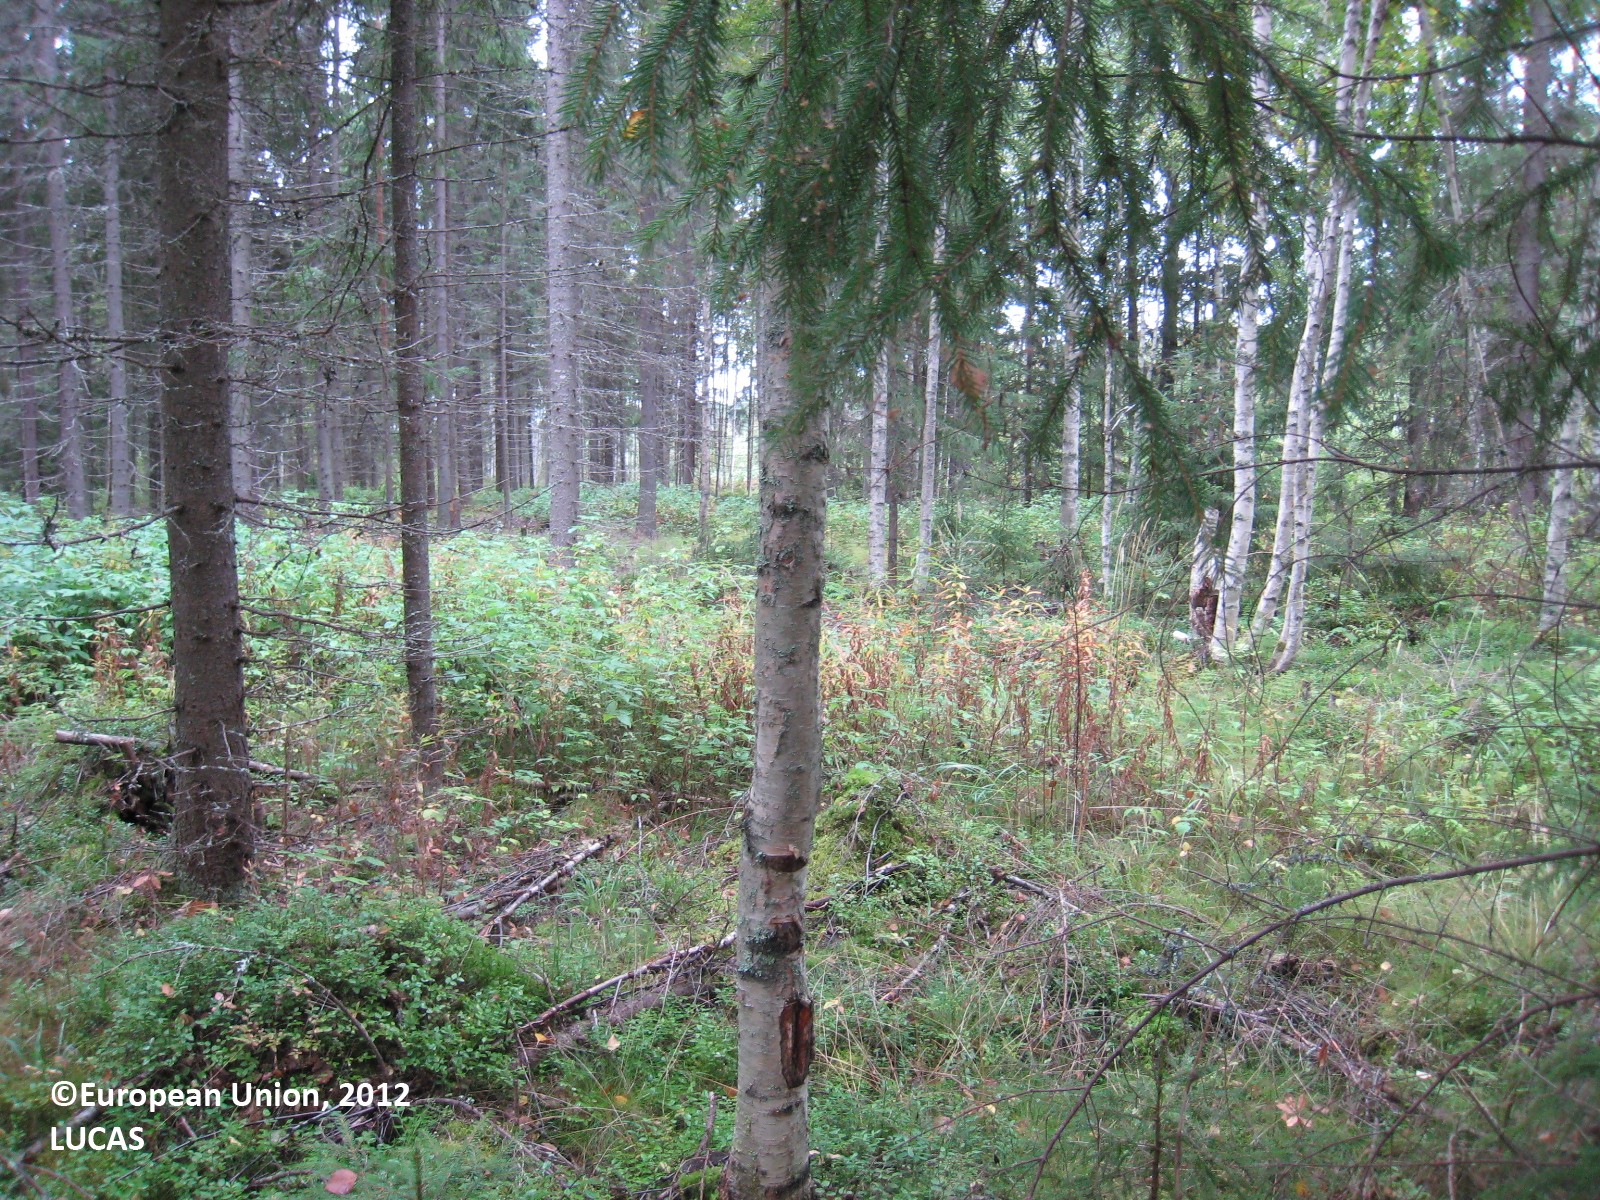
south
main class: Woodland
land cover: Spruce dominated mixed woodland
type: boreal forest
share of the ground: > 75 %
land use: Forestry
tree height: > 5 m
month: August
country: FI
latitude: 62.0546
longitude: 27.2059
